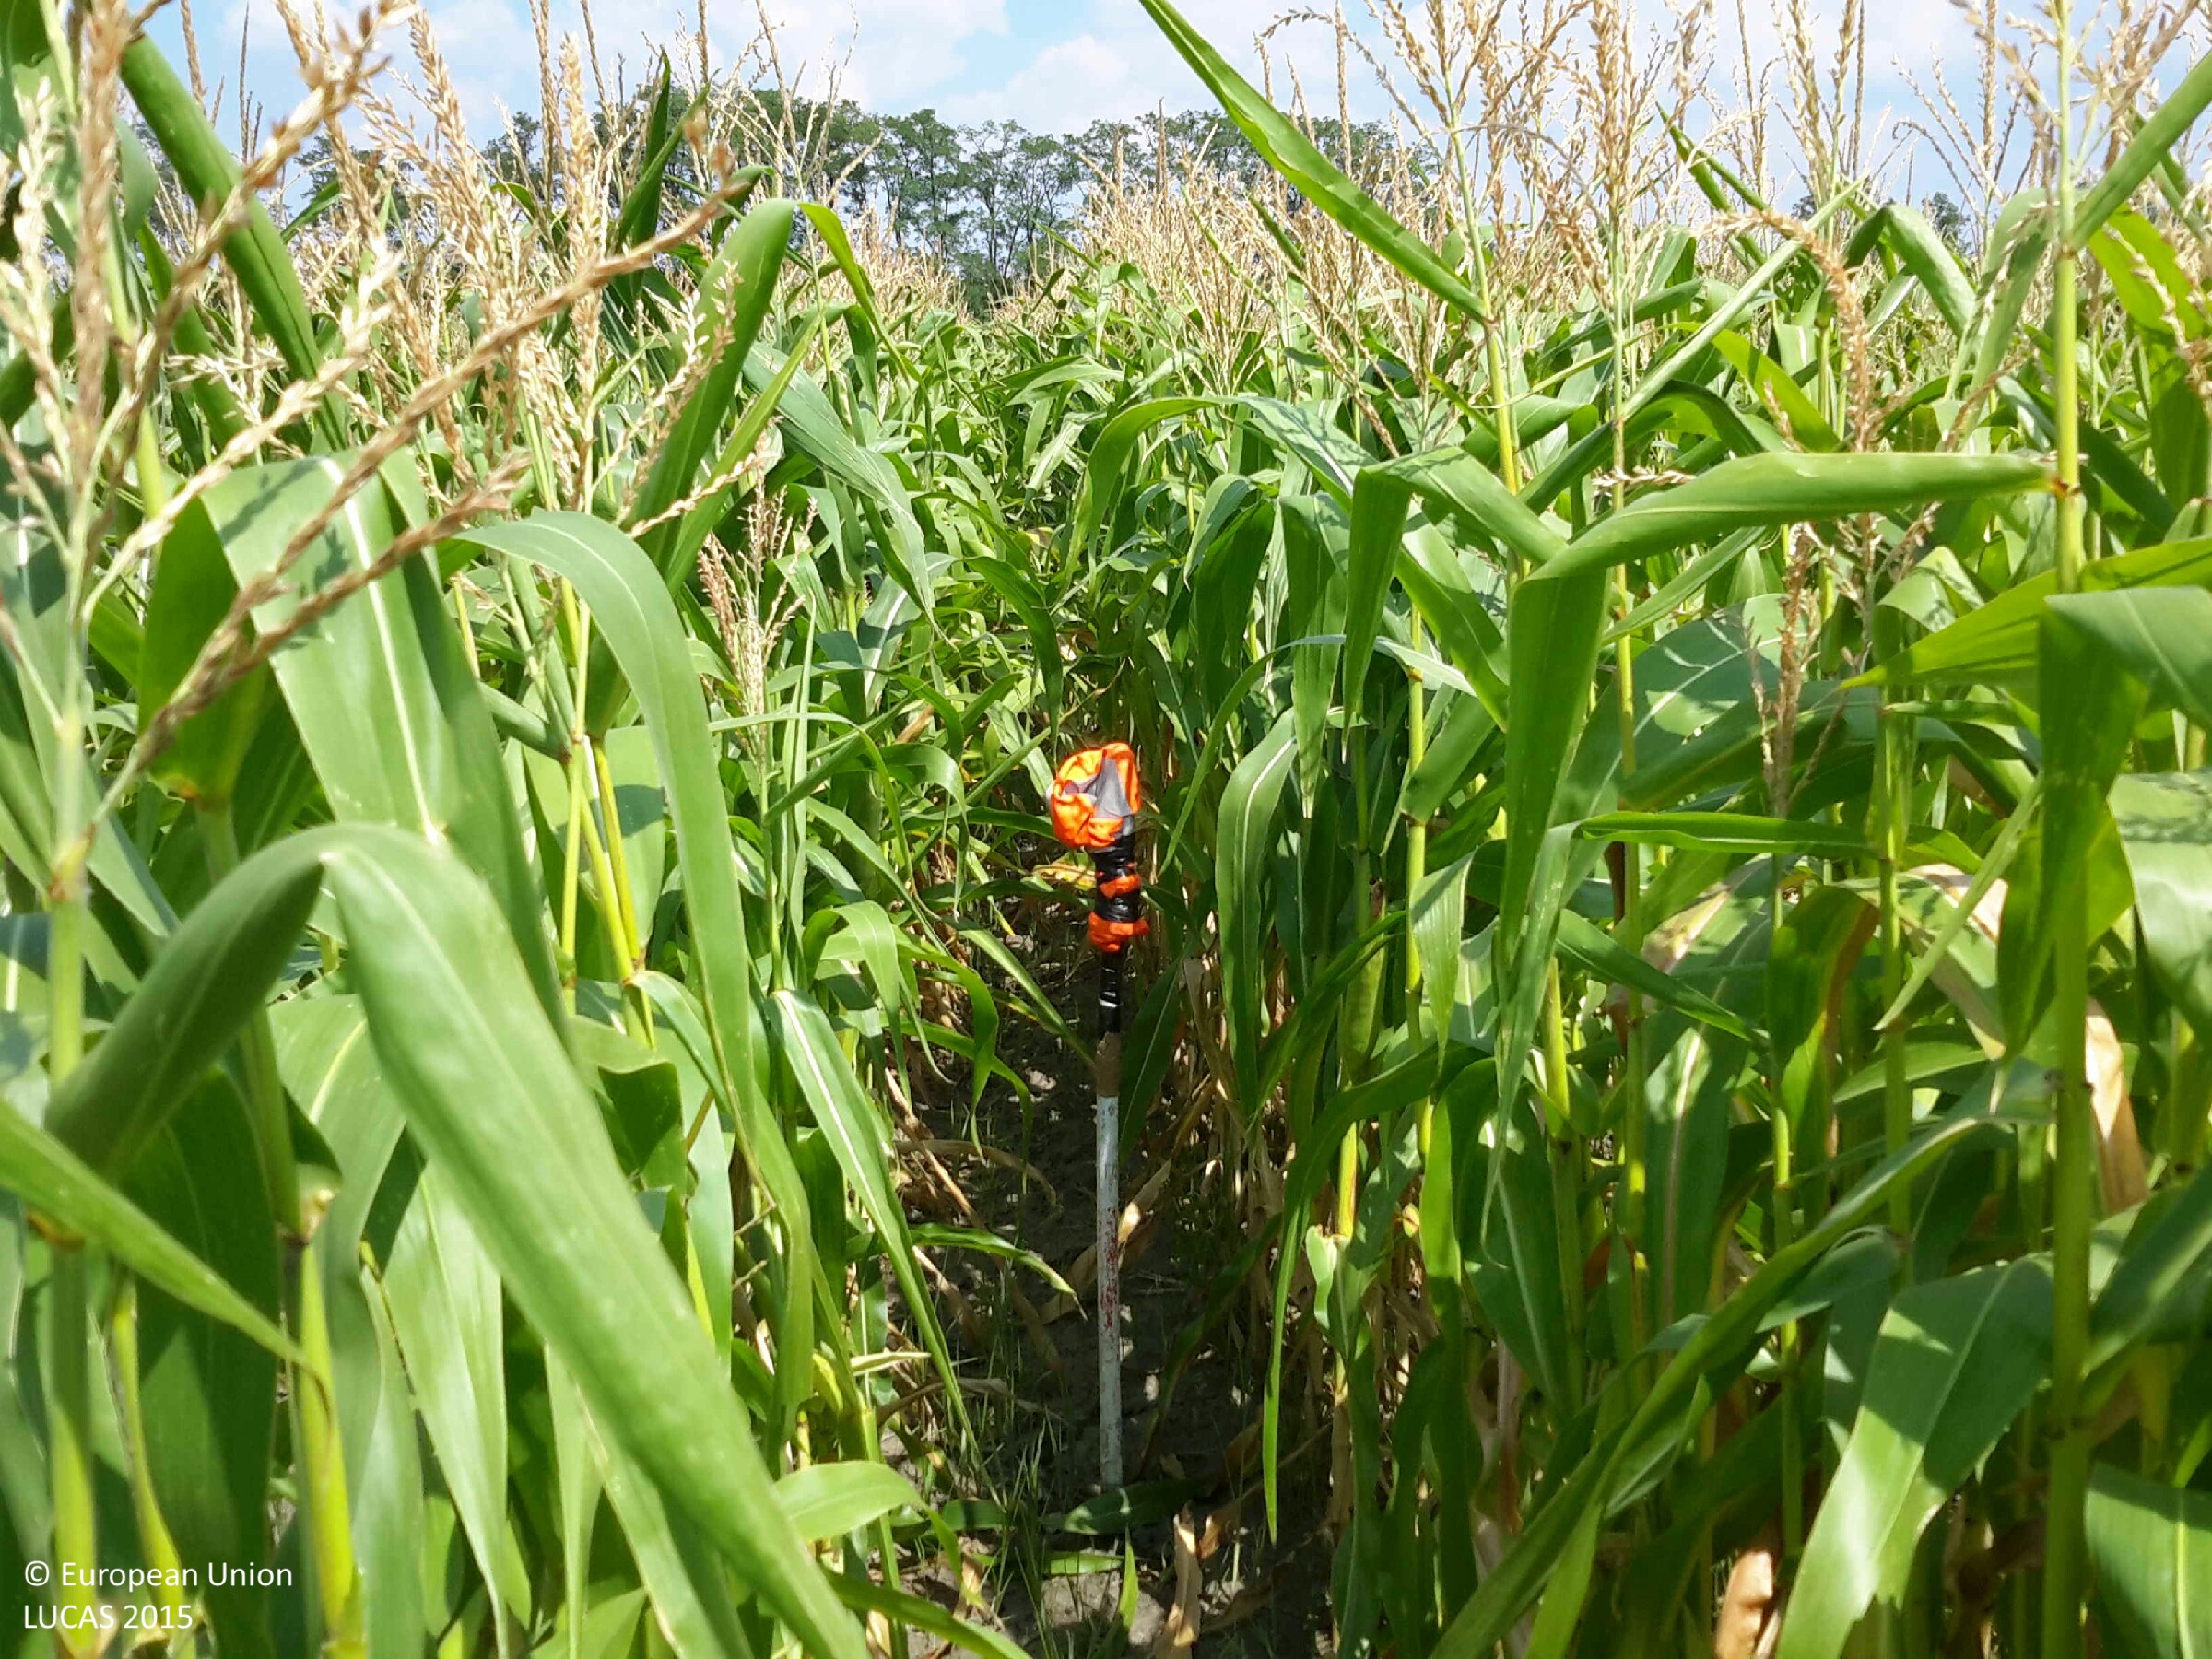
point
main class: Cropland
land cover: Maize
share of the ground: > 75 %
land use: Agriculture (excluding fallow land and kitchen gardens)
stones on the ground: < 10 %
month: August
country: HU
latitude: 47.5816
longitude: 17.3334
